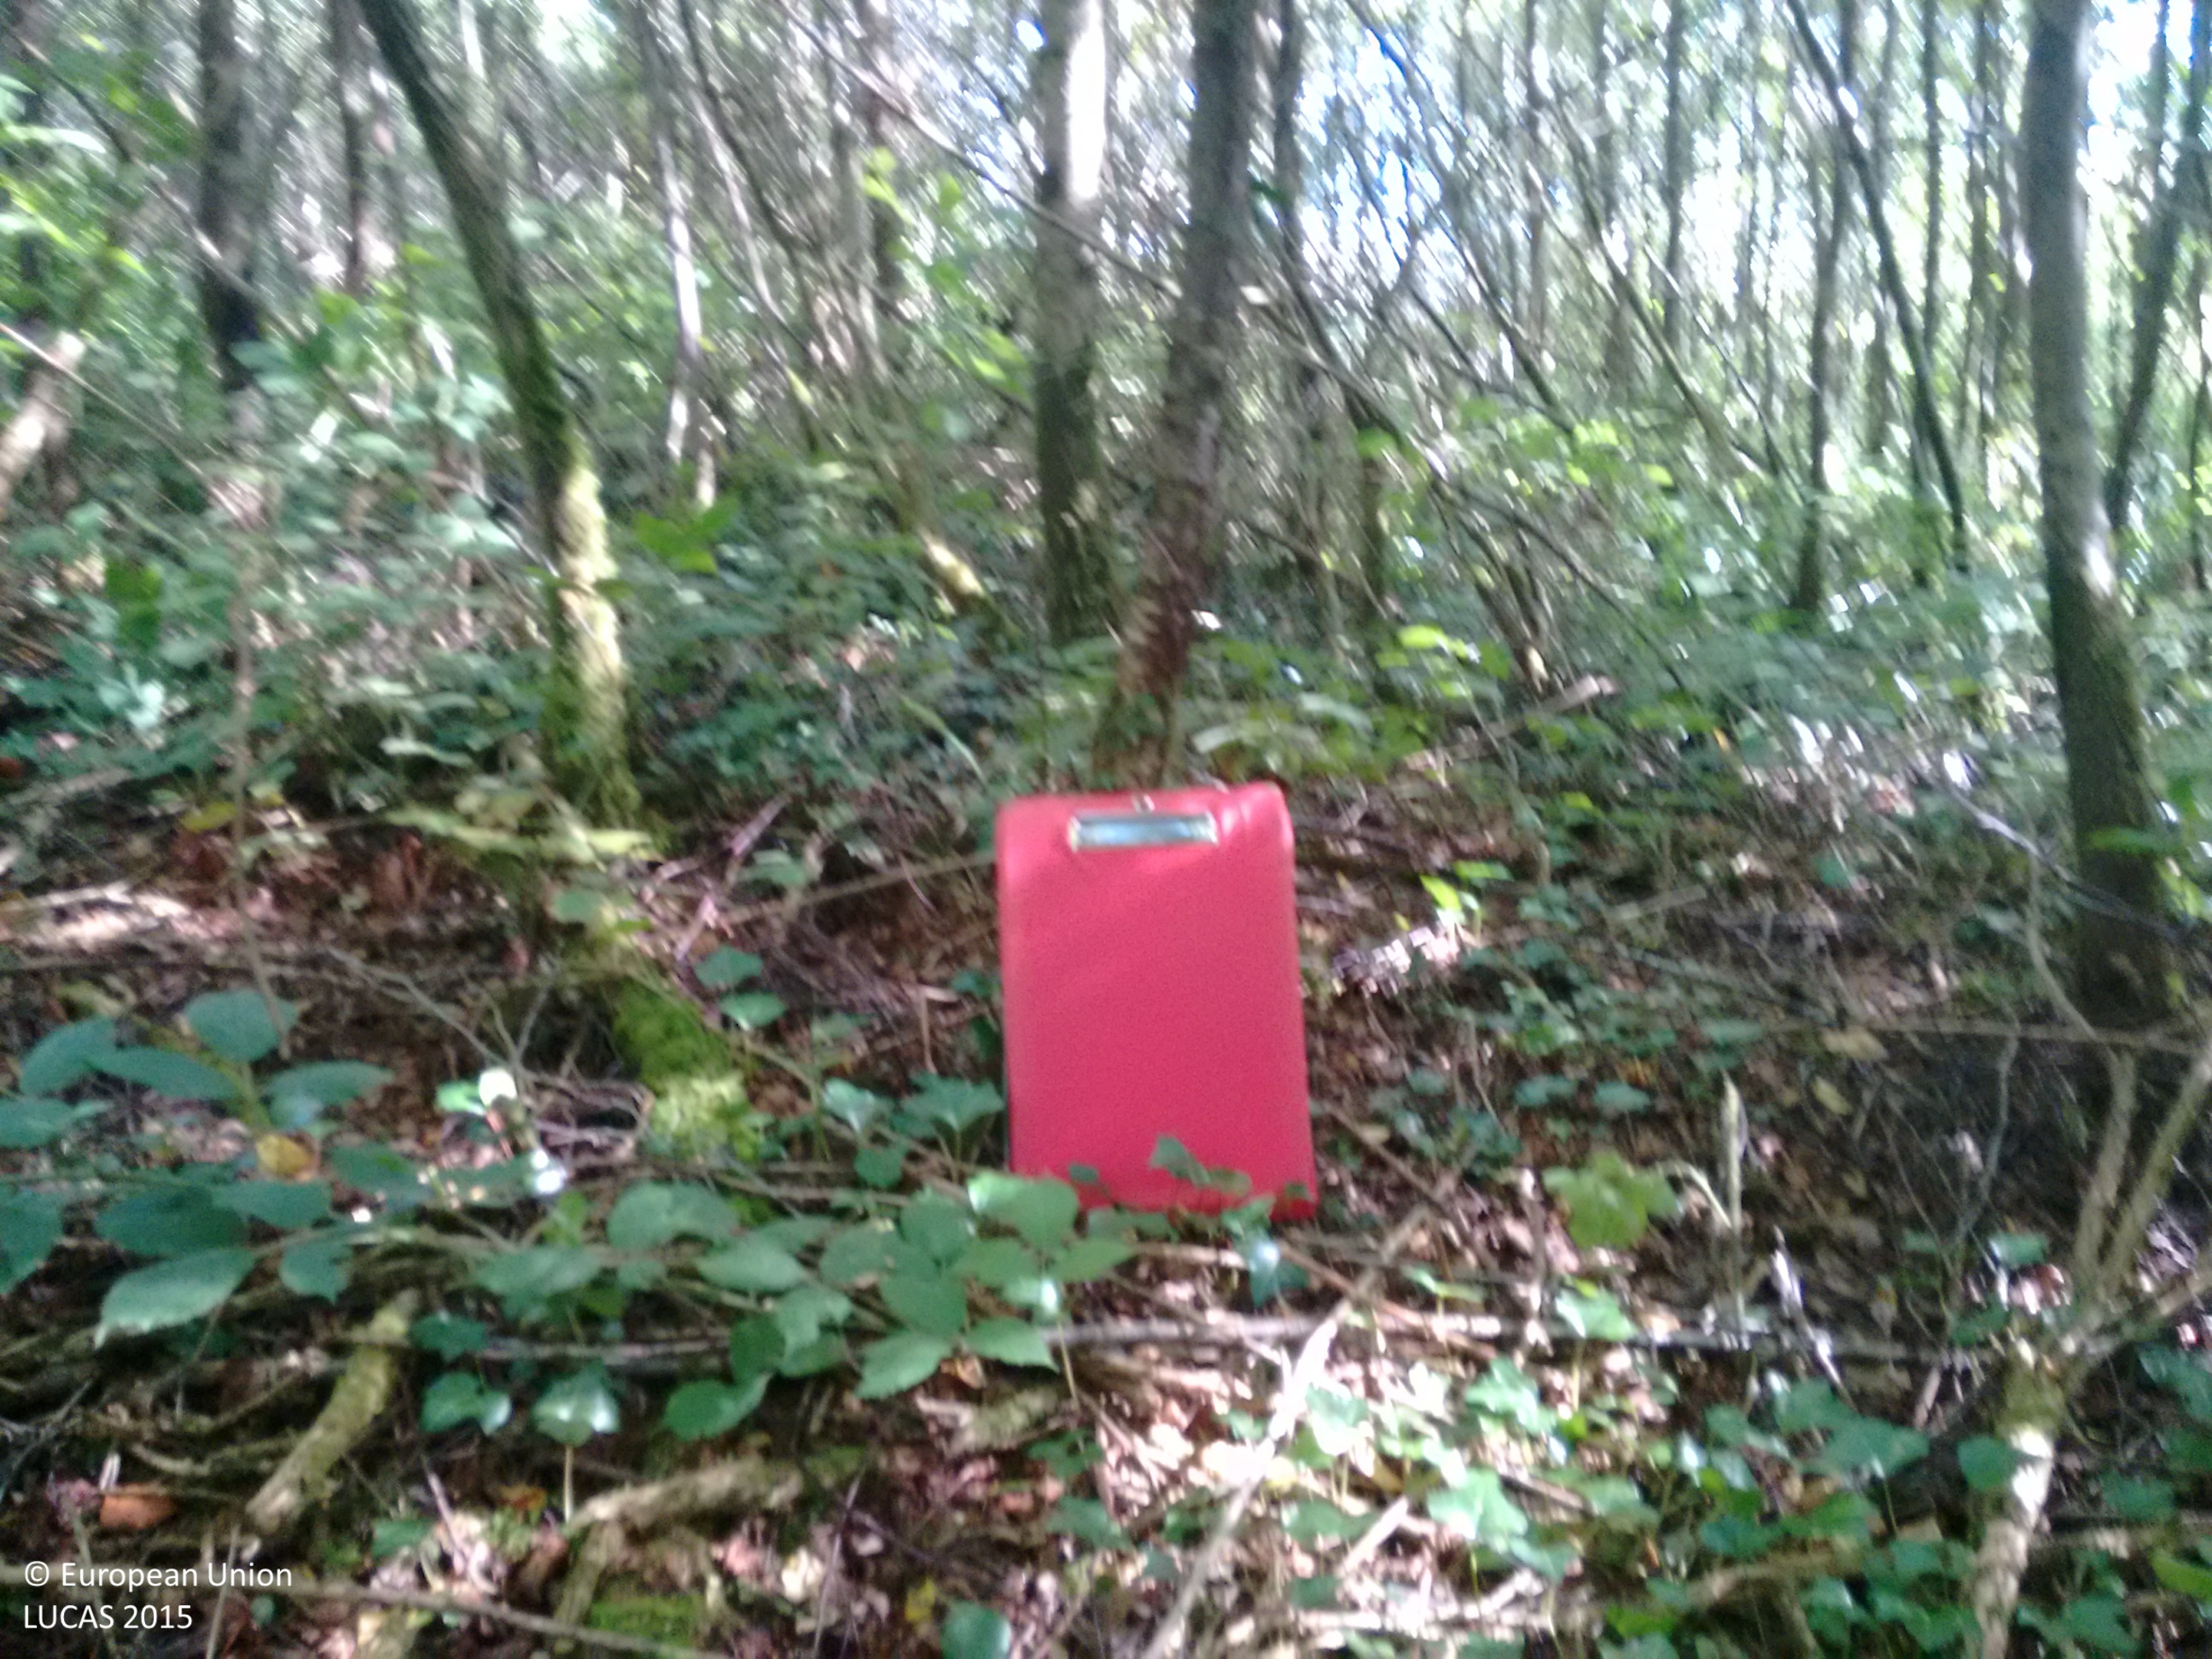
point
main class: Woodland
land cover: Broadleaved woodland
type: acidophilous oak and oak-birch forest
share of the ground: > 75 %
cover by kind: broadleaved forest trees 100 %
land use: Semi-natural and natural areas not in use
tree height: > 5 m
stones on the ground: < 10 %
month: August
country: IE
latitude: 51.8957
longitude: -9.5479
